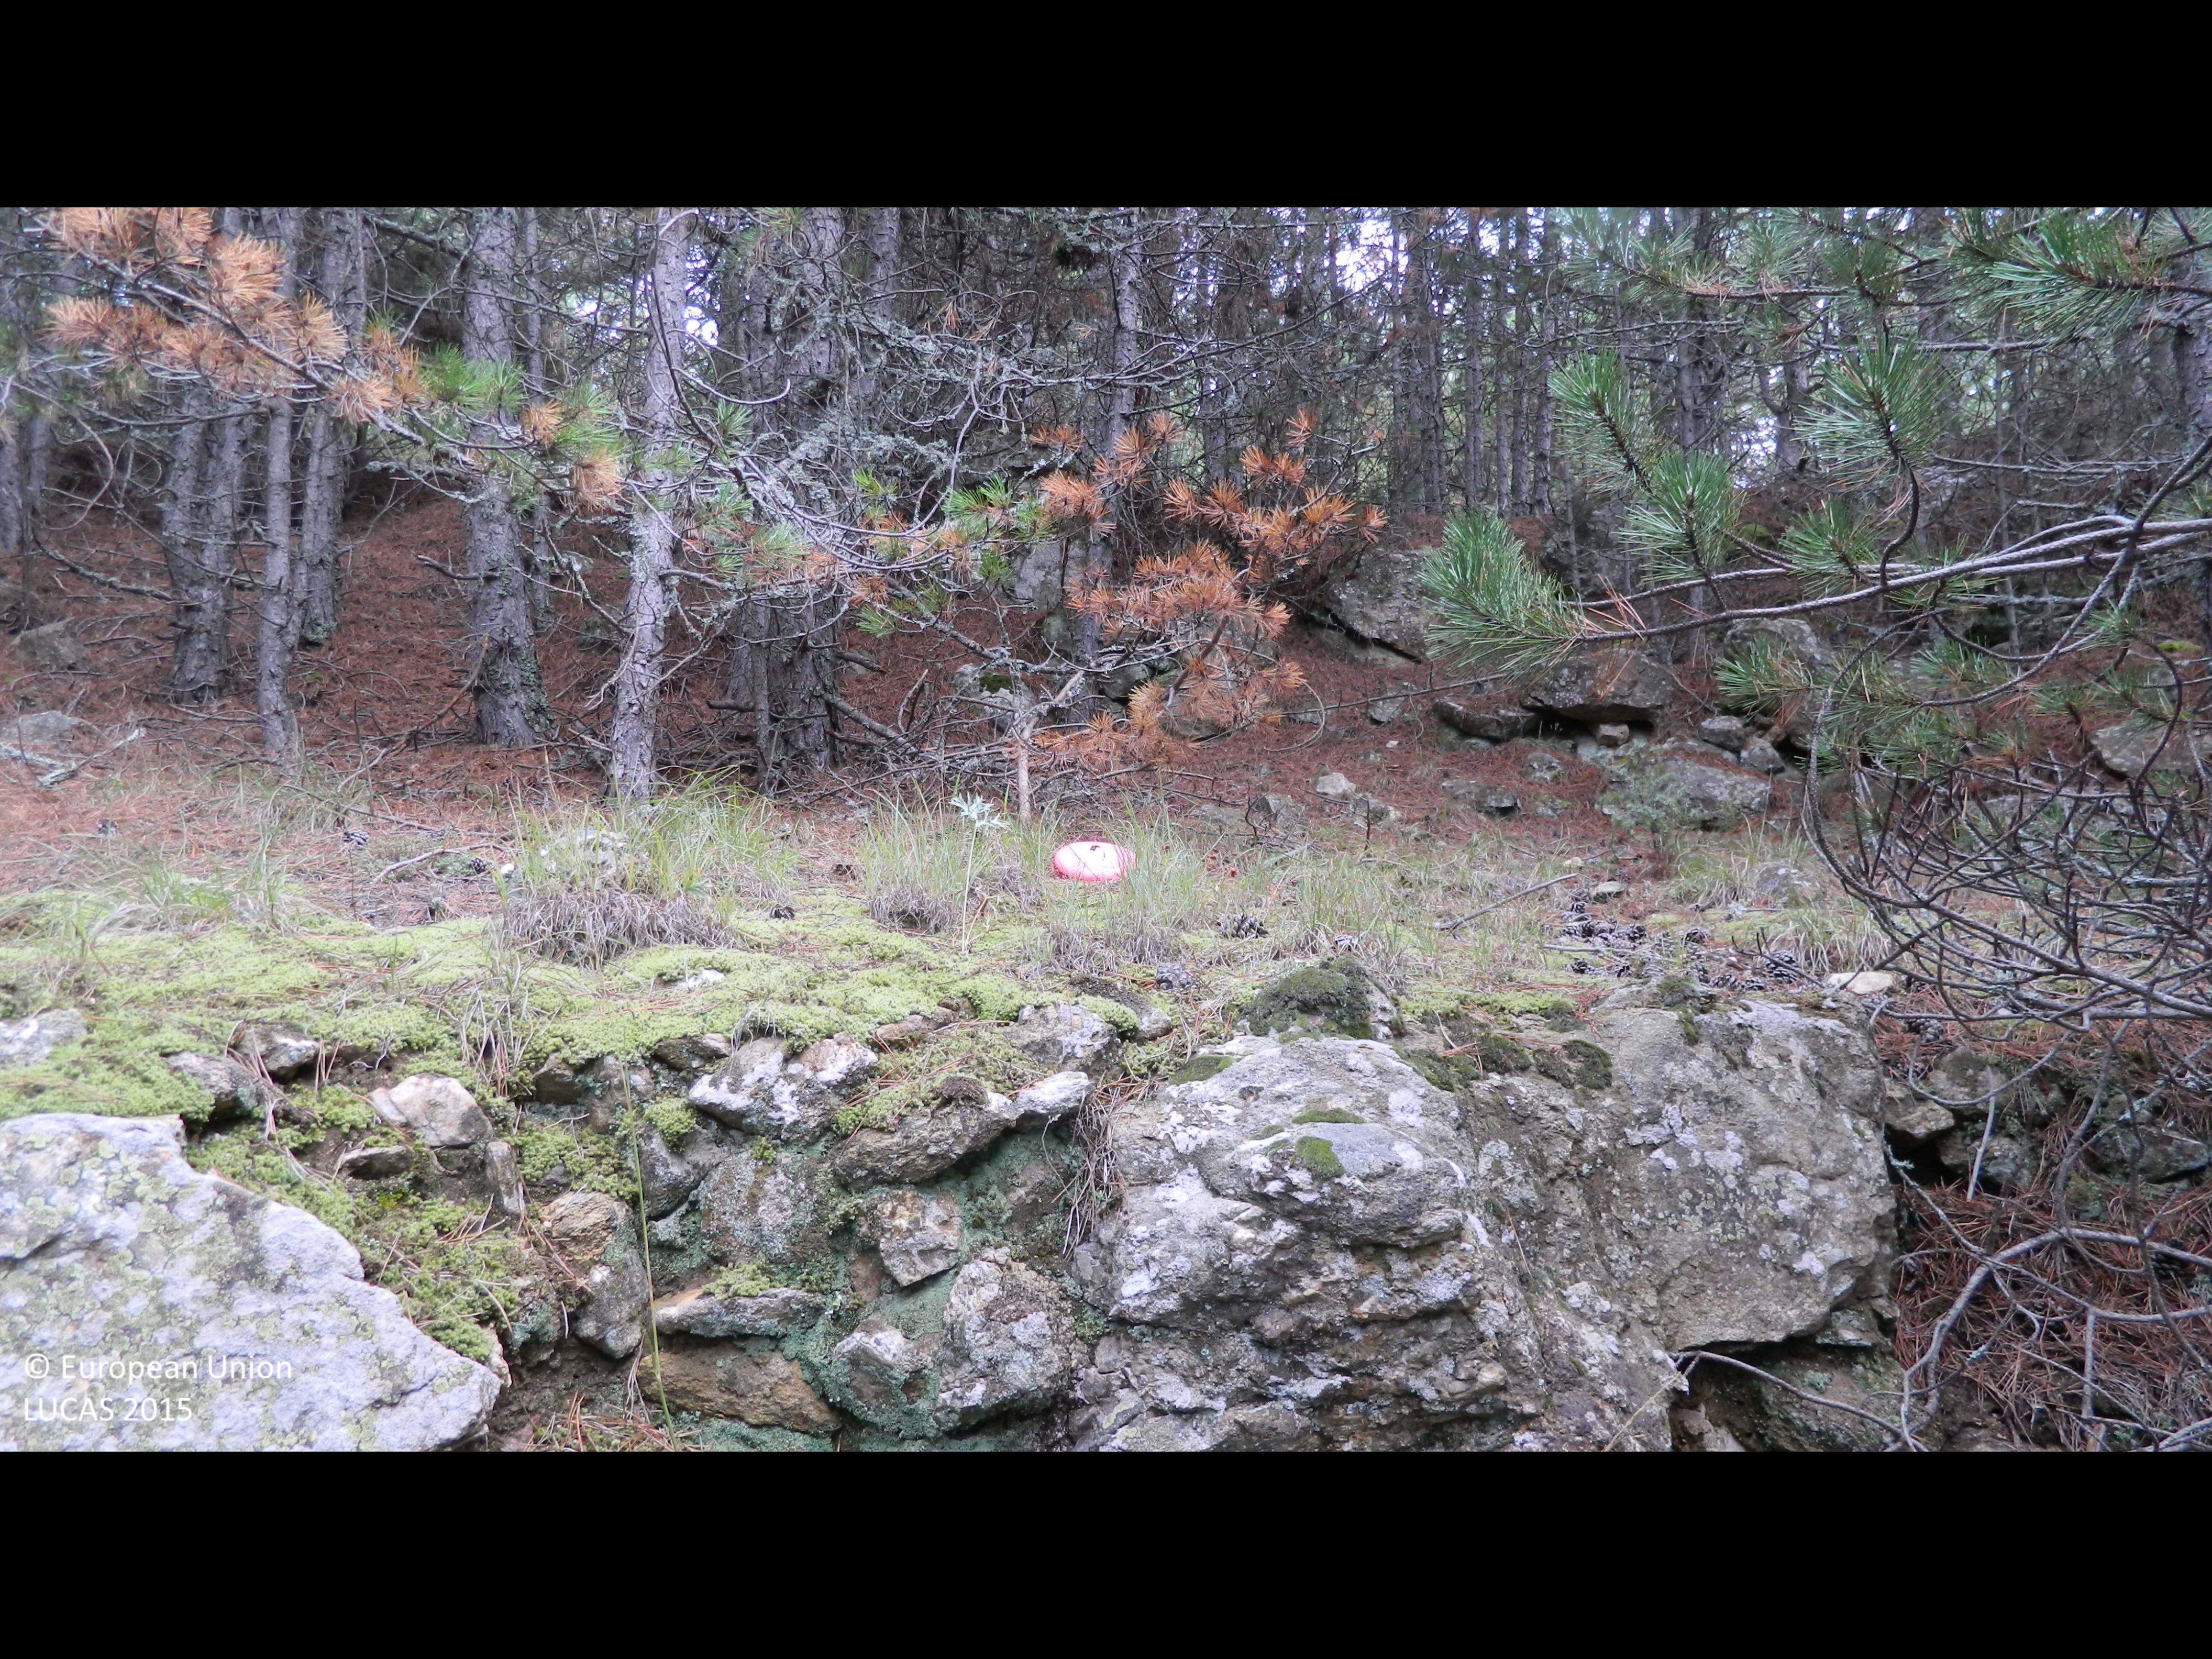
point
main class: Woodland
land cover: Pine dominated coniferous woodland
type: hemiboreal forest and nemoral coniferous forest and mixed broadleaved-coniferous forest
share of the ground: > 75 %
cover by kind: coniferous forest trees 80 %, herbaceous plants 10 %, unconsolidated bare surface 10 %
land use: Forestry
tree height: > 5 m
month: September
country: BG
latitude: 41.5239
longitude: 24.0415
